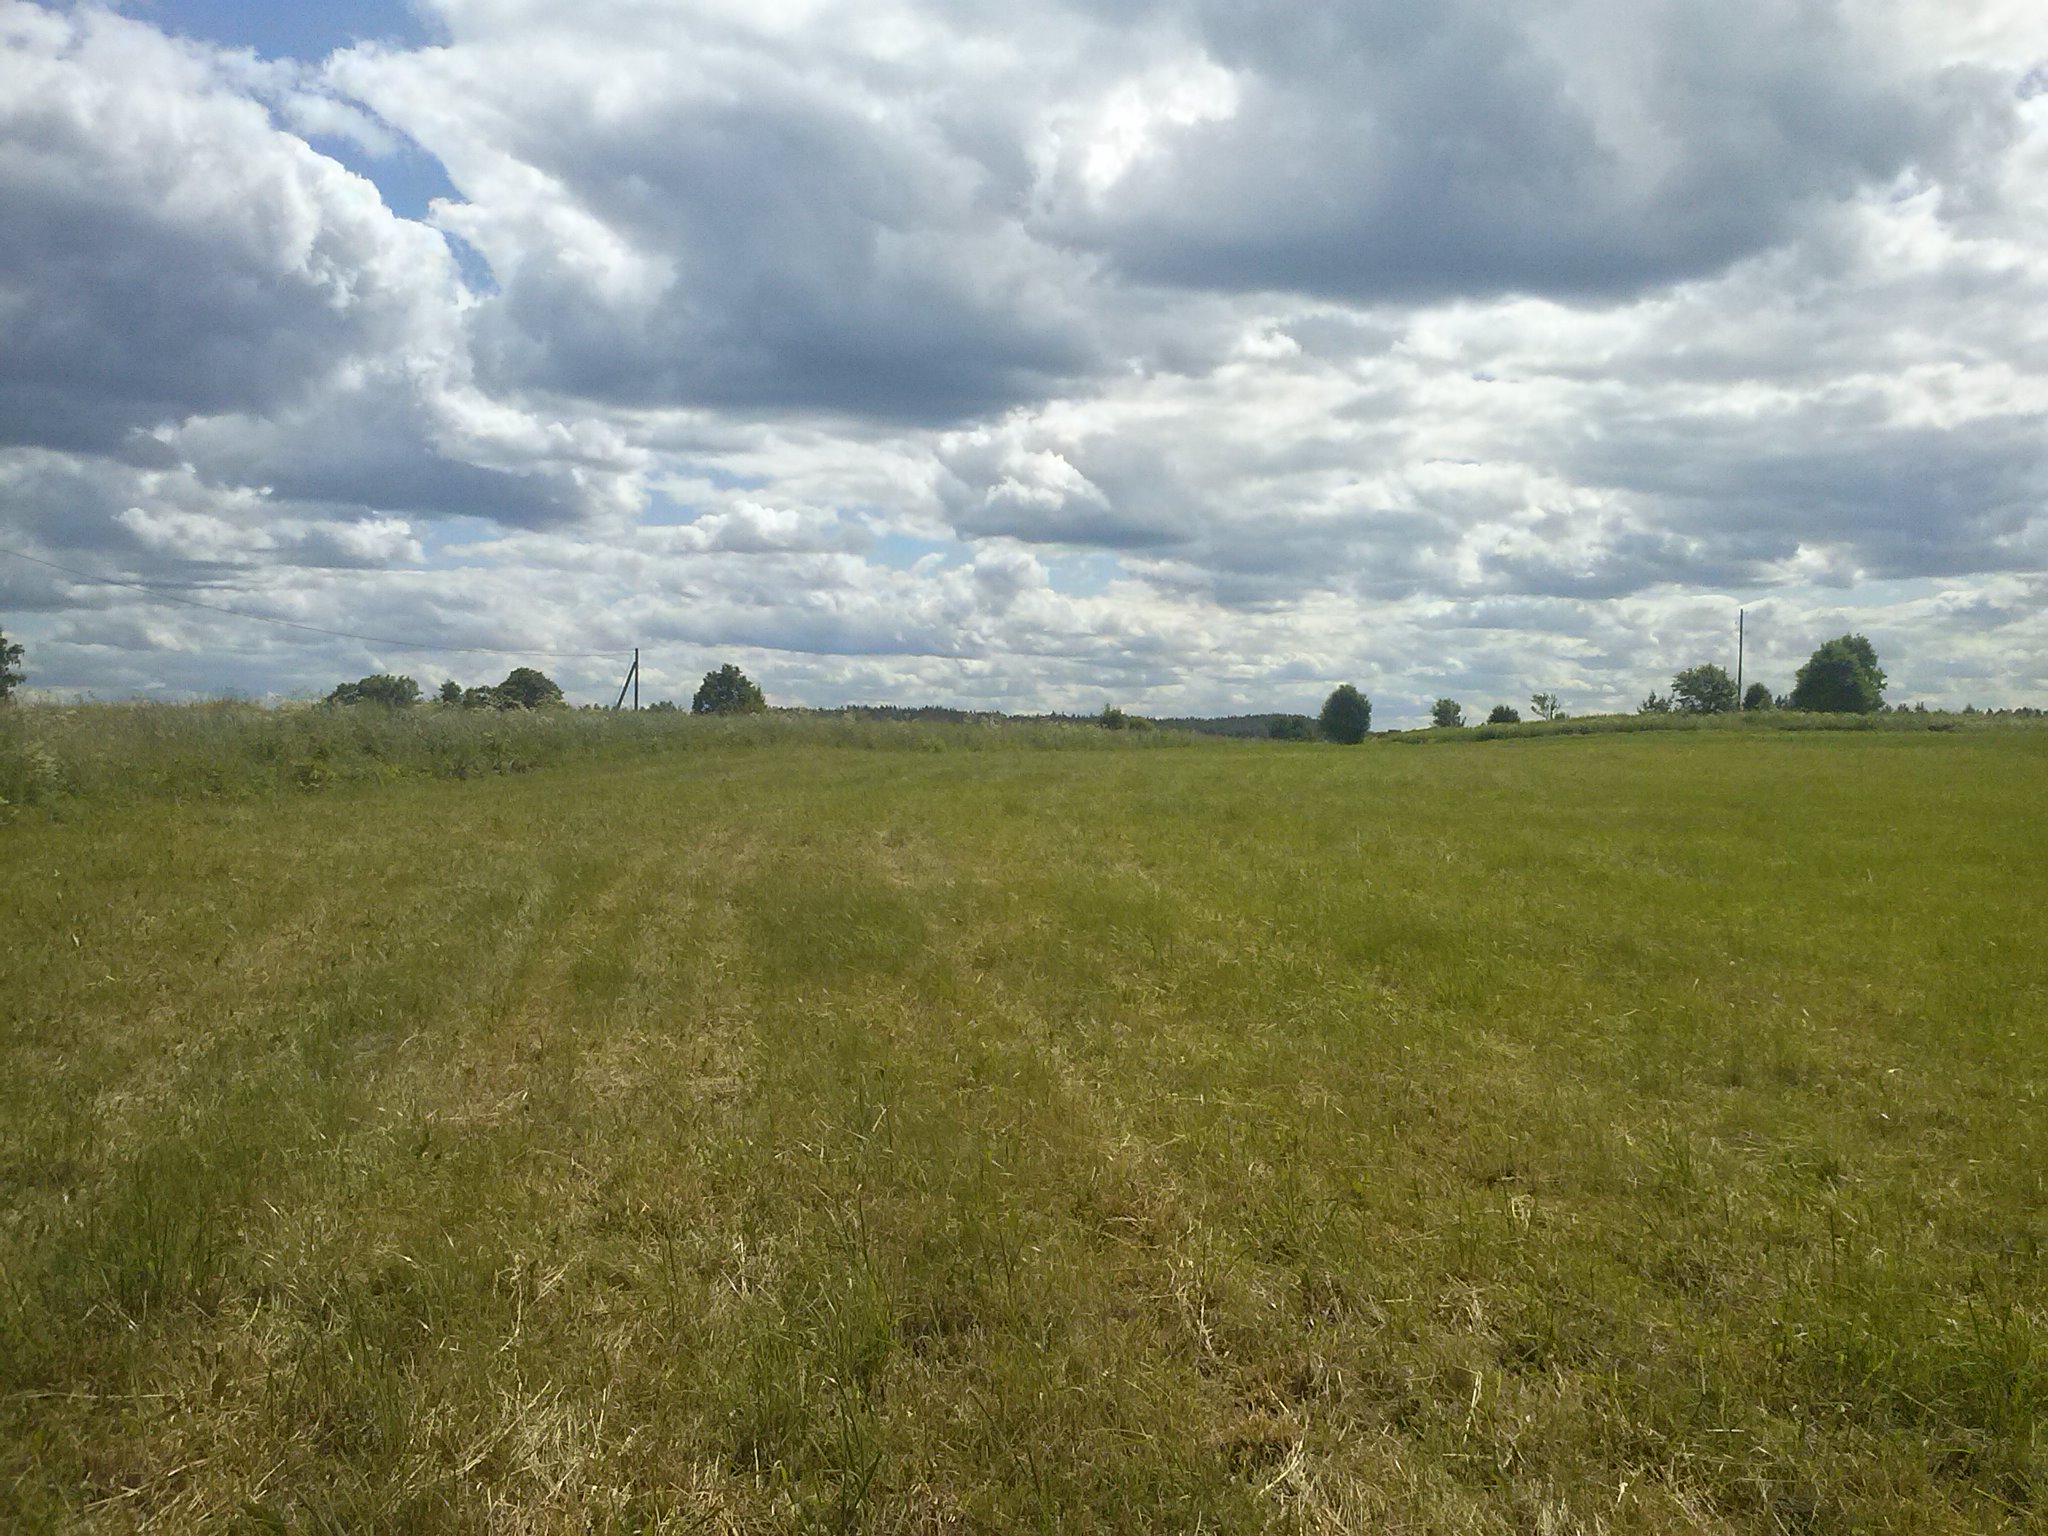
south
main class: Grassland
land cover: Grassland without tree/shrub cover
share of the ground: > 75 %
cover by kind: herbaceous plants 100 %
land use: Agriculture (excluding fallow land and kitchen gardens)
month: June
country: LV
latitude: 56.3877
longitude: 27.6623
